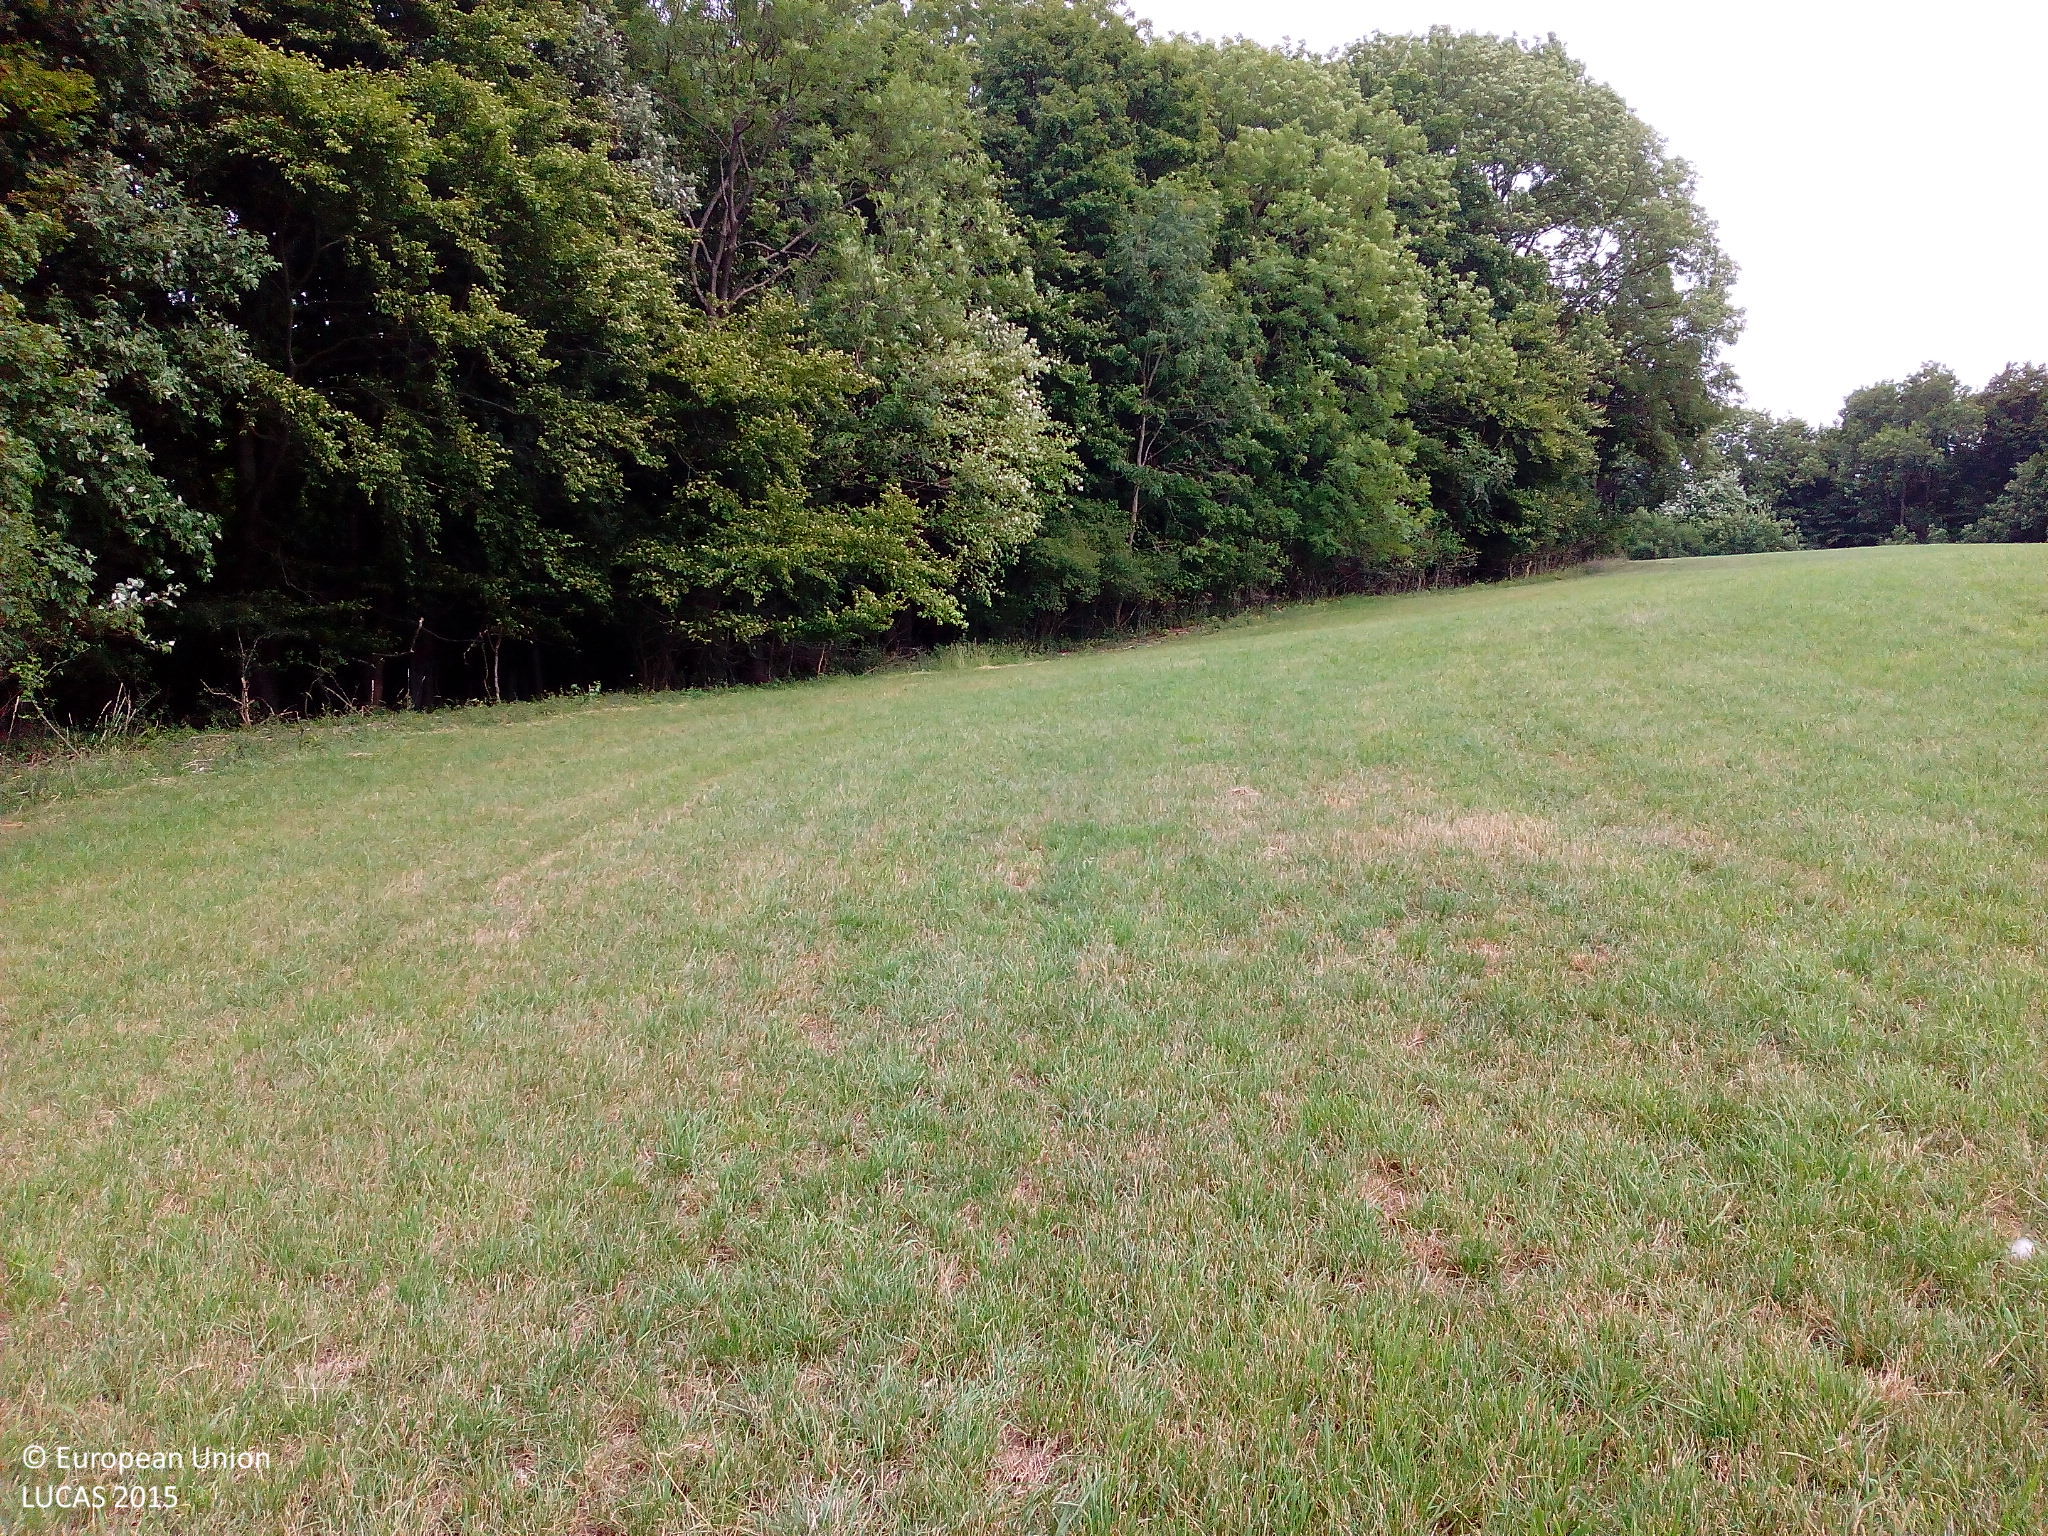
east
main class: Grassland
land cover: Grassland without tree/shrub cover
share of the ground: > 75 %
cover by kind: herbaceous plants 100 %
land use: Agriculture (excluding fallow land and kitchen gardens)
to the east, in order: Grassland without tree/shrub cover; Broadleaved woodland
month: July
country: DE
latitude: 50.8135
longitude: 9.9007
